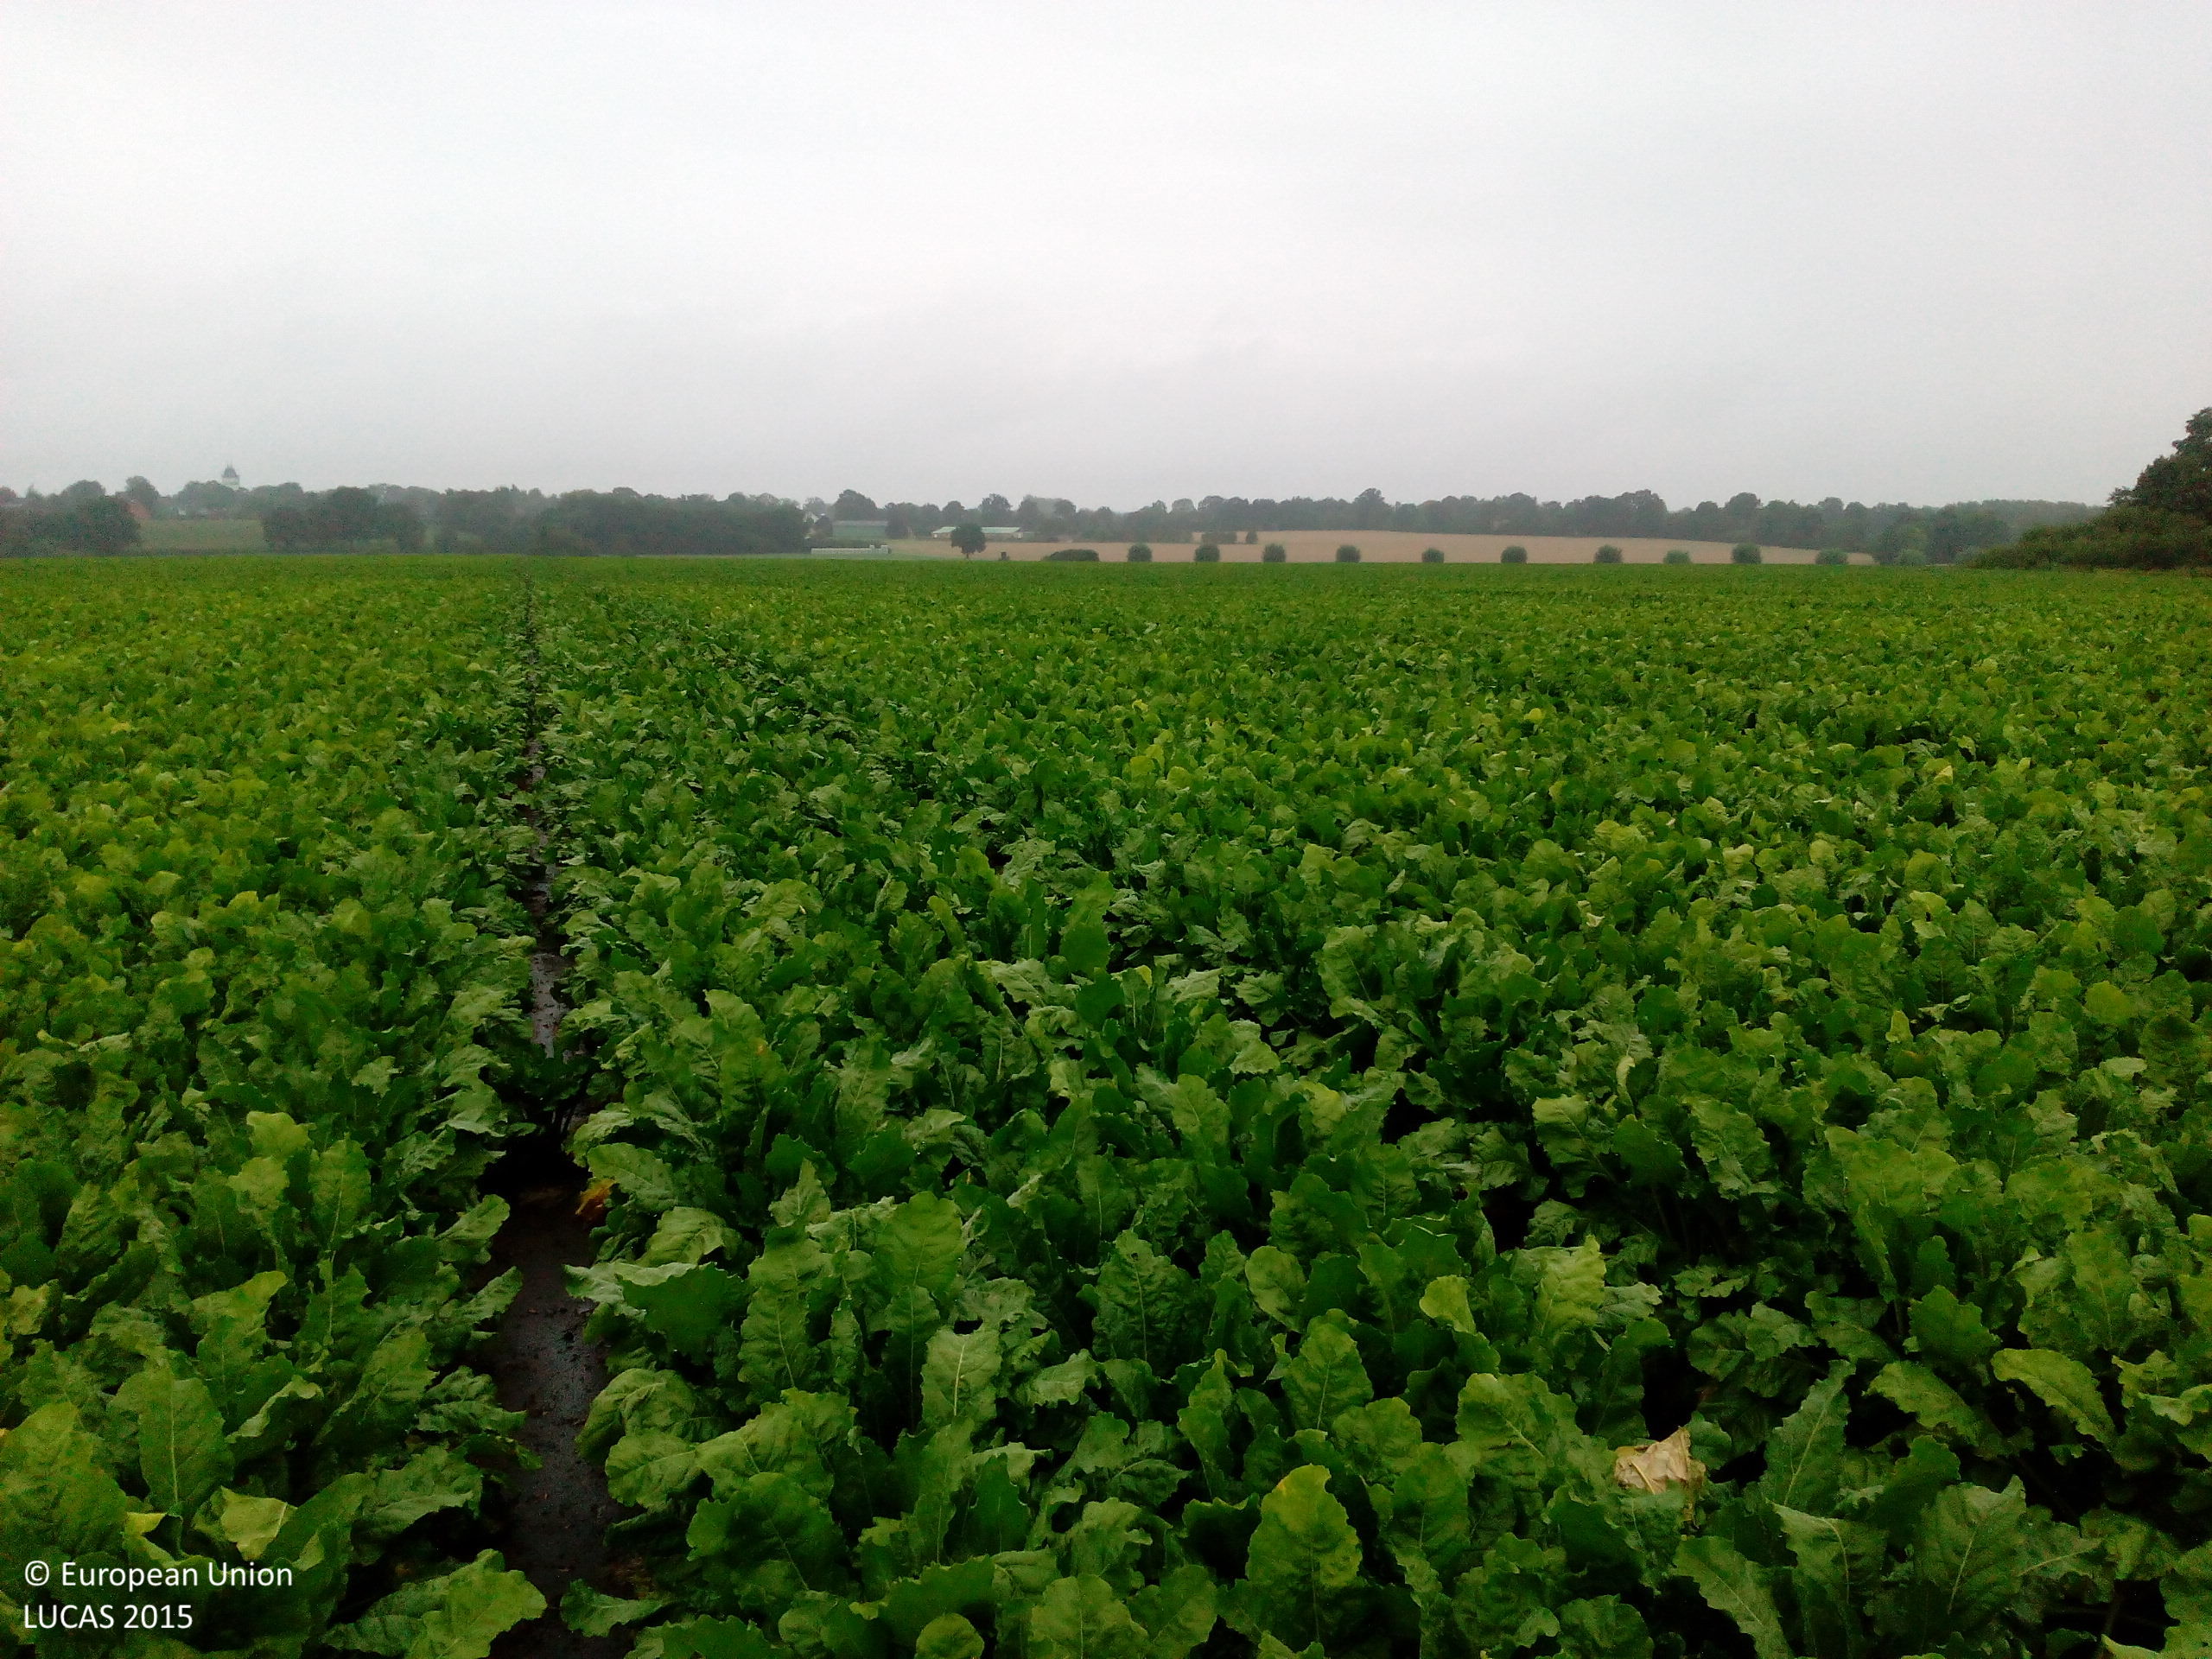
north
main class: Cropland
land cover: Sugar beet
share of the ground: > 75 %
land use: Agriculture (excluding fallow land and kitchen gardens)
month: August
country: DE
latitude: 53.7793
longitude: 9.9242
